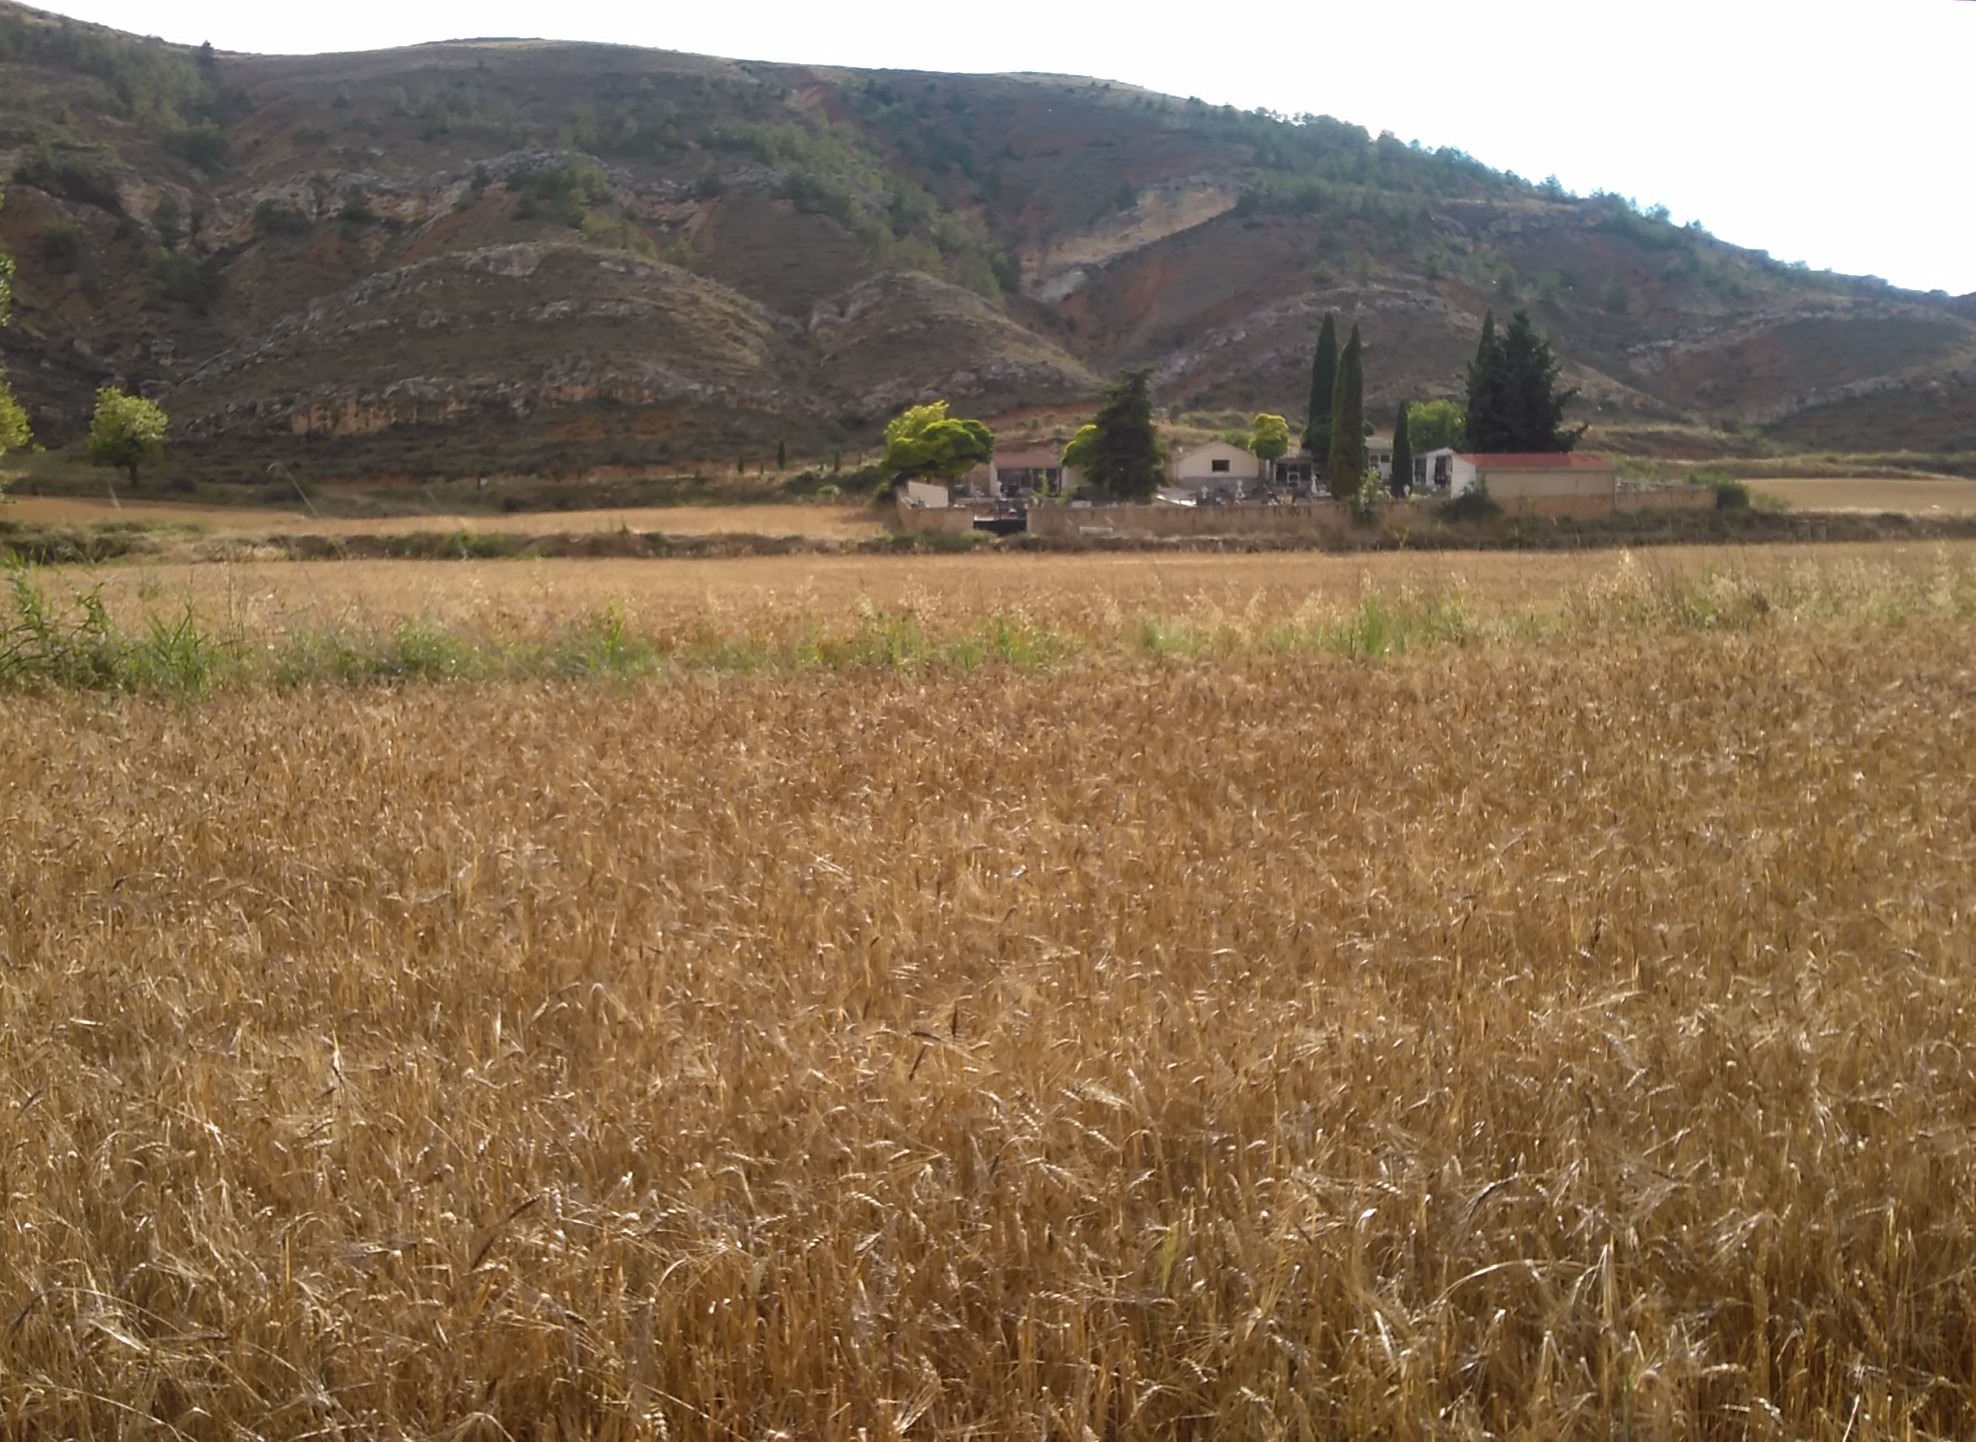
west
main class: Cropland
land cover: Common wheat
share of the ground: > 75 %
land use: Agriculture (excluding fallow land and kitchen gardens)
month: July
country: ES
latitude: 41.4083
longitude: -2.0039
